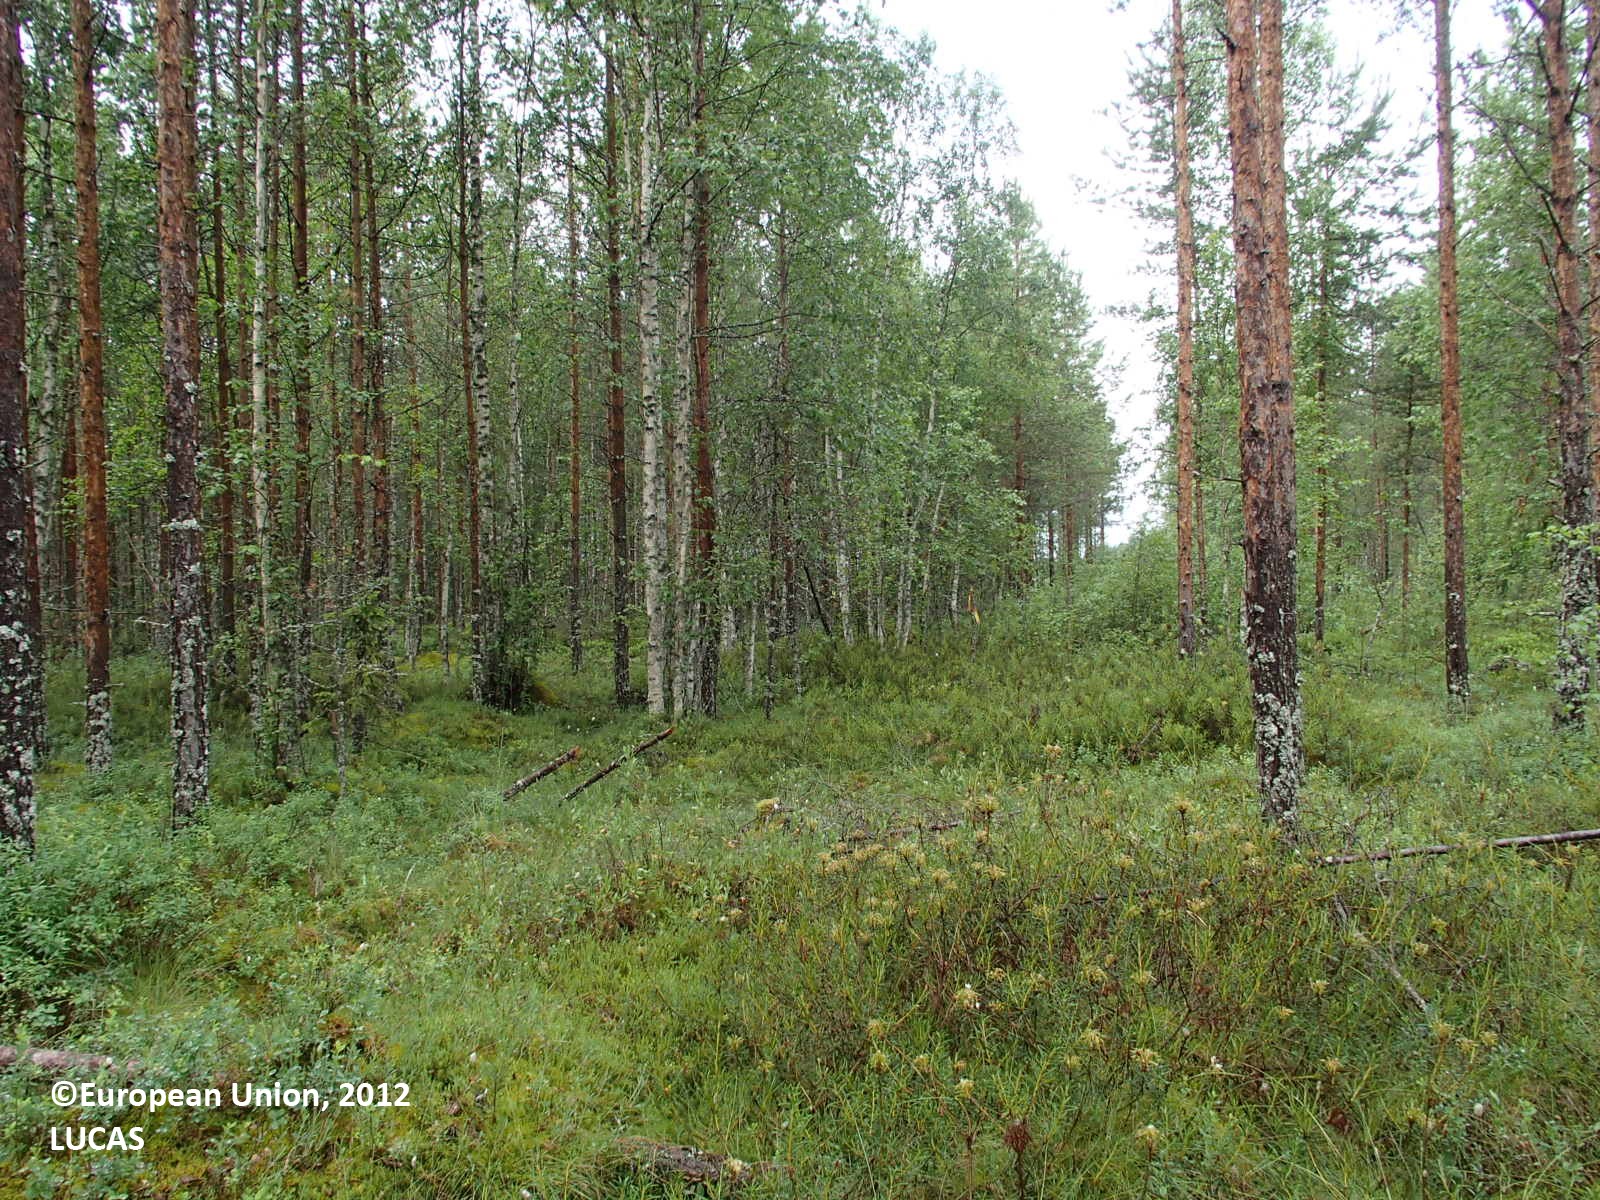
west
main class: Woodland
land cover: Pine dominated mixed woodland
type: boreal forest
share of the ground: > 75 %
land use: Forestry
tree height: > 5 m
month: July
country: FI
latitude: 64.3723
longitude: 26.3796
